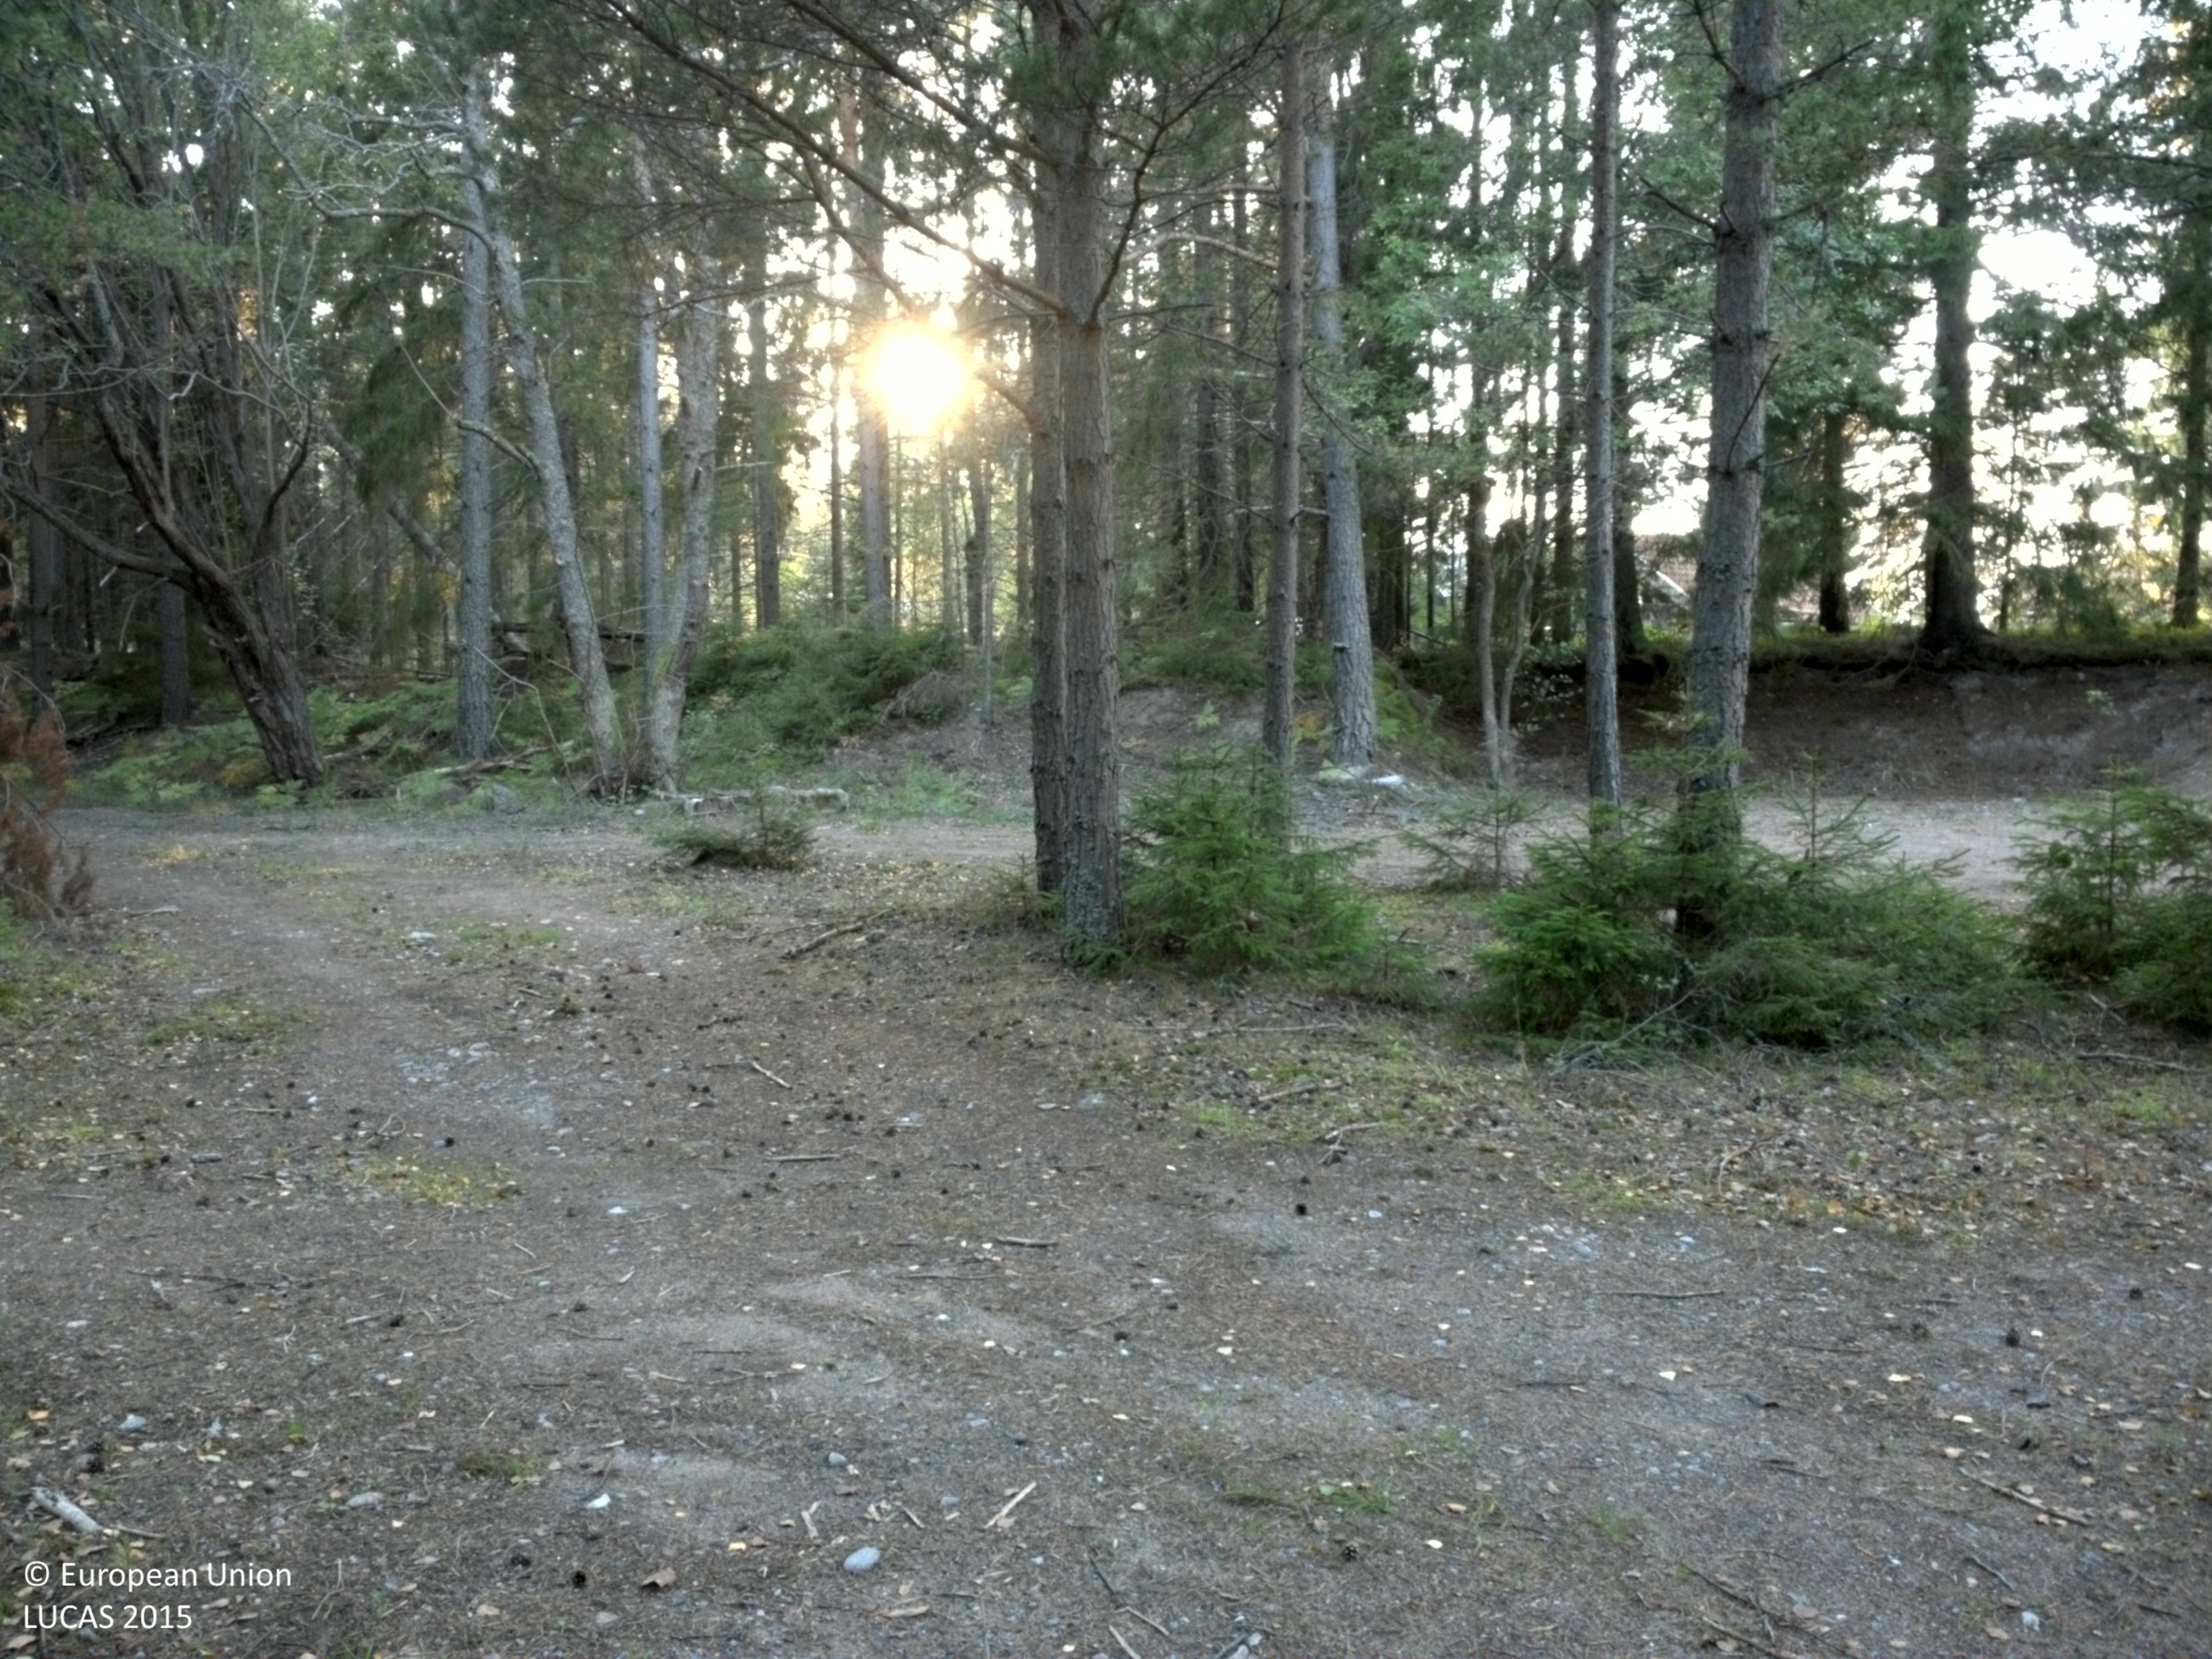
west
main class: Woodland
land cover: Pine dominated coniferous woodland
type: boreal forest
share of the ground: 50 - 75 %
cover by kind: coniferous forest trees 60 %, lichens and mosses 25 %, broadleaved forest trees 10 %, unconsolidated bare surface 5 %
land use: Amenities, museums, leisure
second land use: Sport
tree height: > 5 m
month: September
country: SE
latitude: 59.2959
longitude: 18.6937
